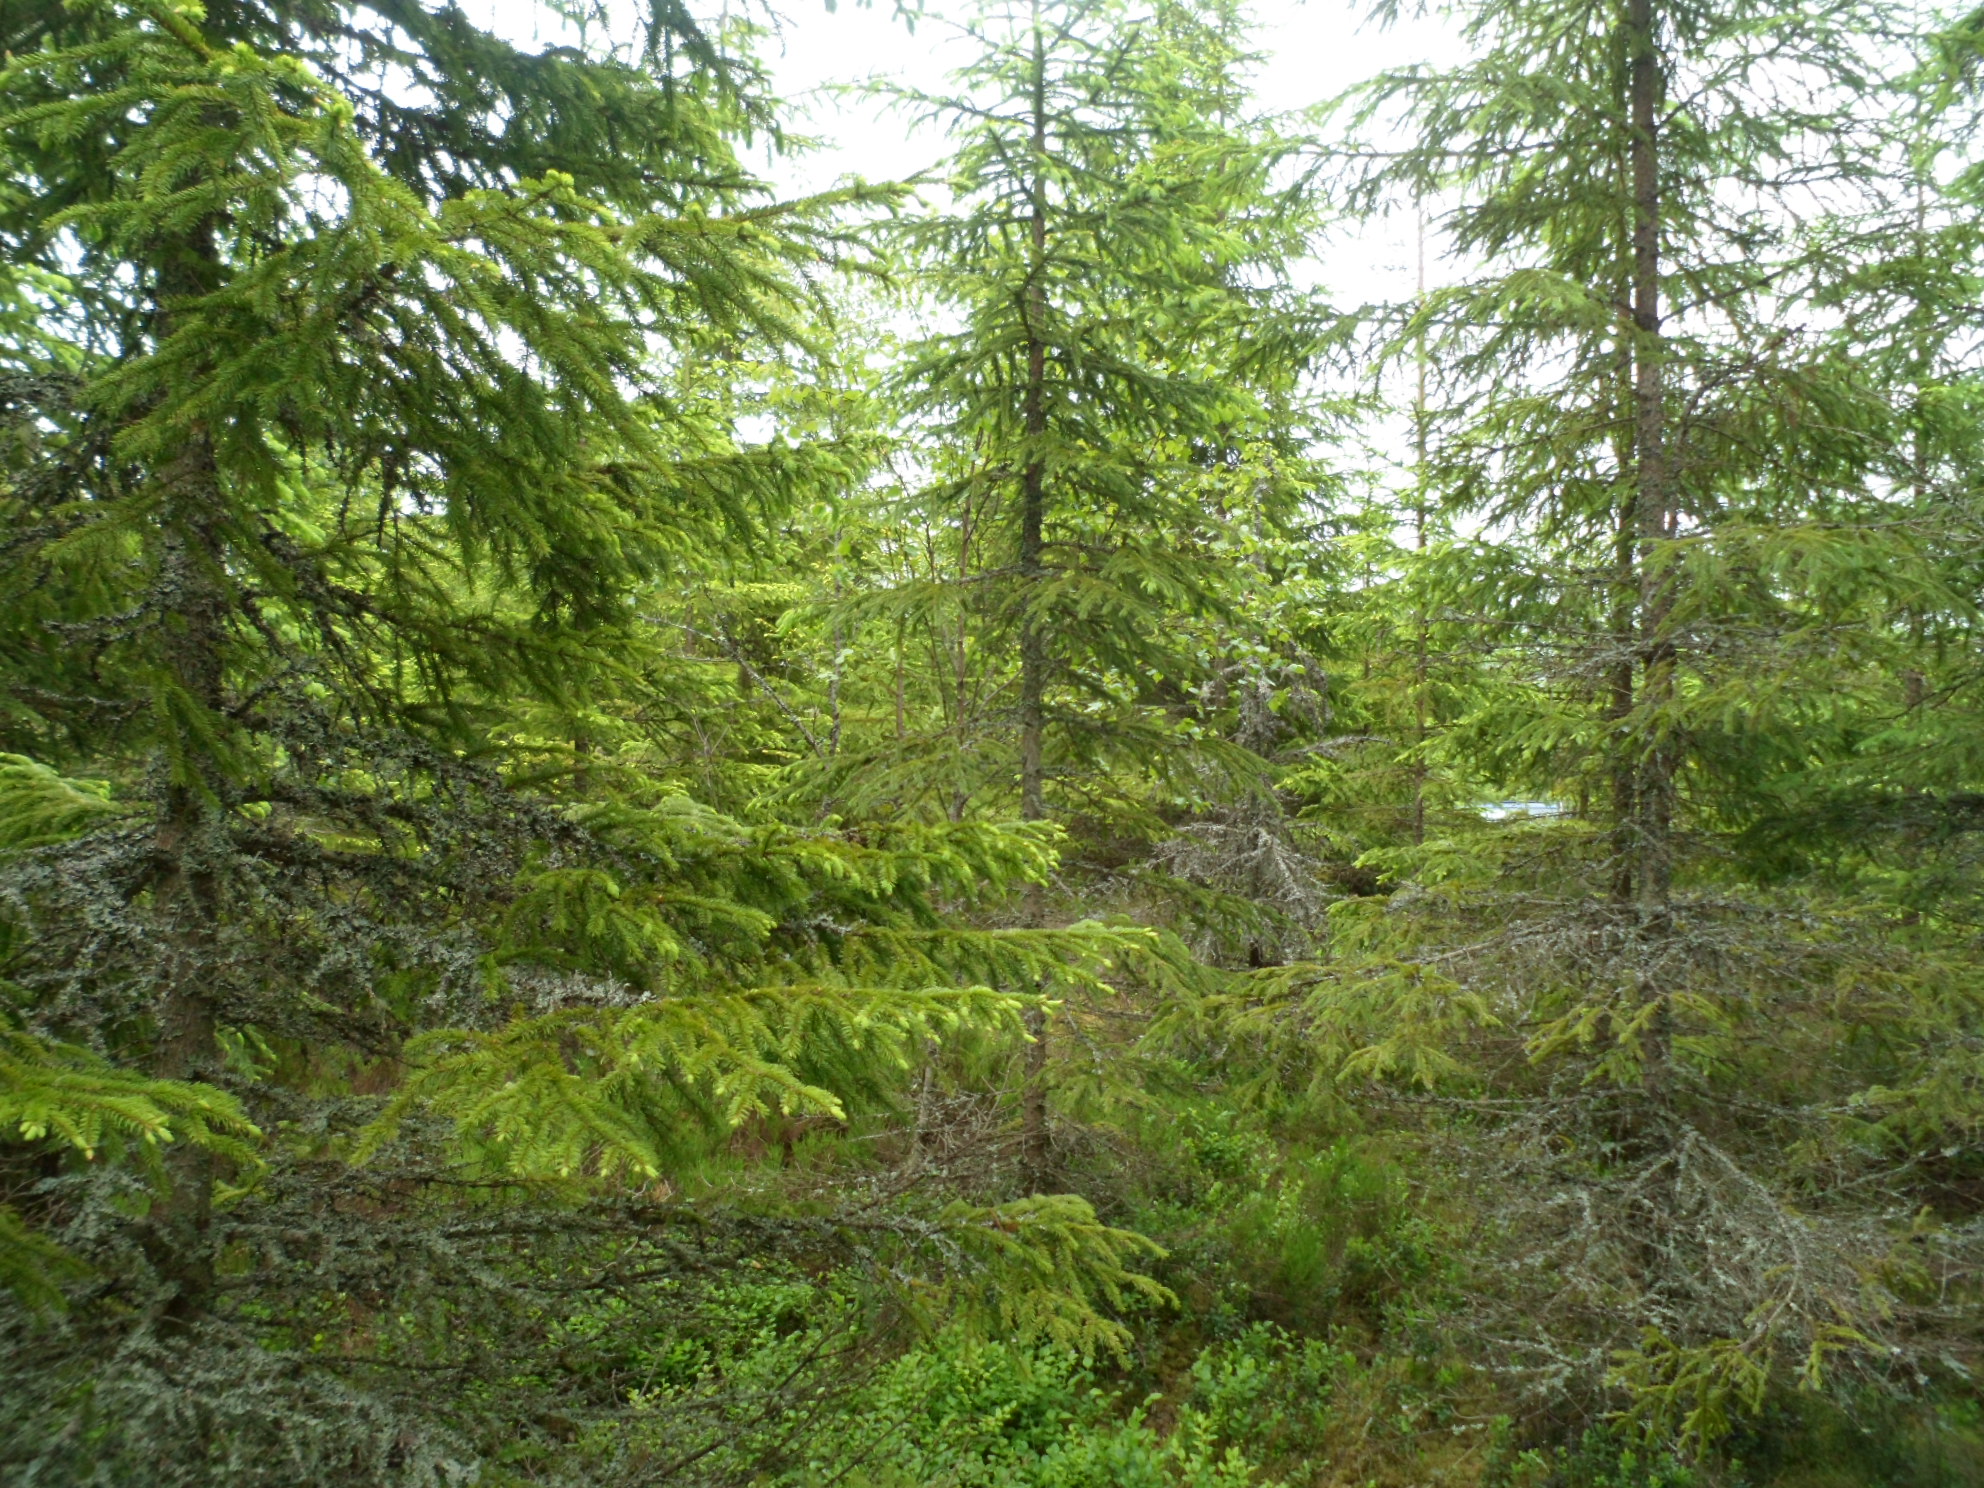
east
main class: Woodland
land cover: Spruce dominated coniferous woodland
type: boreal forest
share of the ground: > 75 %
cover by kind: coniferous forest trees 75 %, shrubs 10 %, lichens and mosses 10 %, herbaceous plants 5 %
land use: Forestry
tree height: > 5 m
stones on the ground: 25 - 50 %
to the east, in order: Spruce dominated coniferous woodland; Shrubland with sparse tree cover; Paved roads, cycling and walking lanes; Shrubland with sparse tree cover; Spruce dominated coniferous woodland; Pine dominated coniferous woodland; Spruce dominated coniferous woodland; Pine dominated coniferous woodland; Inland marshes; Pine dominated mixed woodland
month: June
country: SE
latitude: 57.0878
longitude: 15.2944
